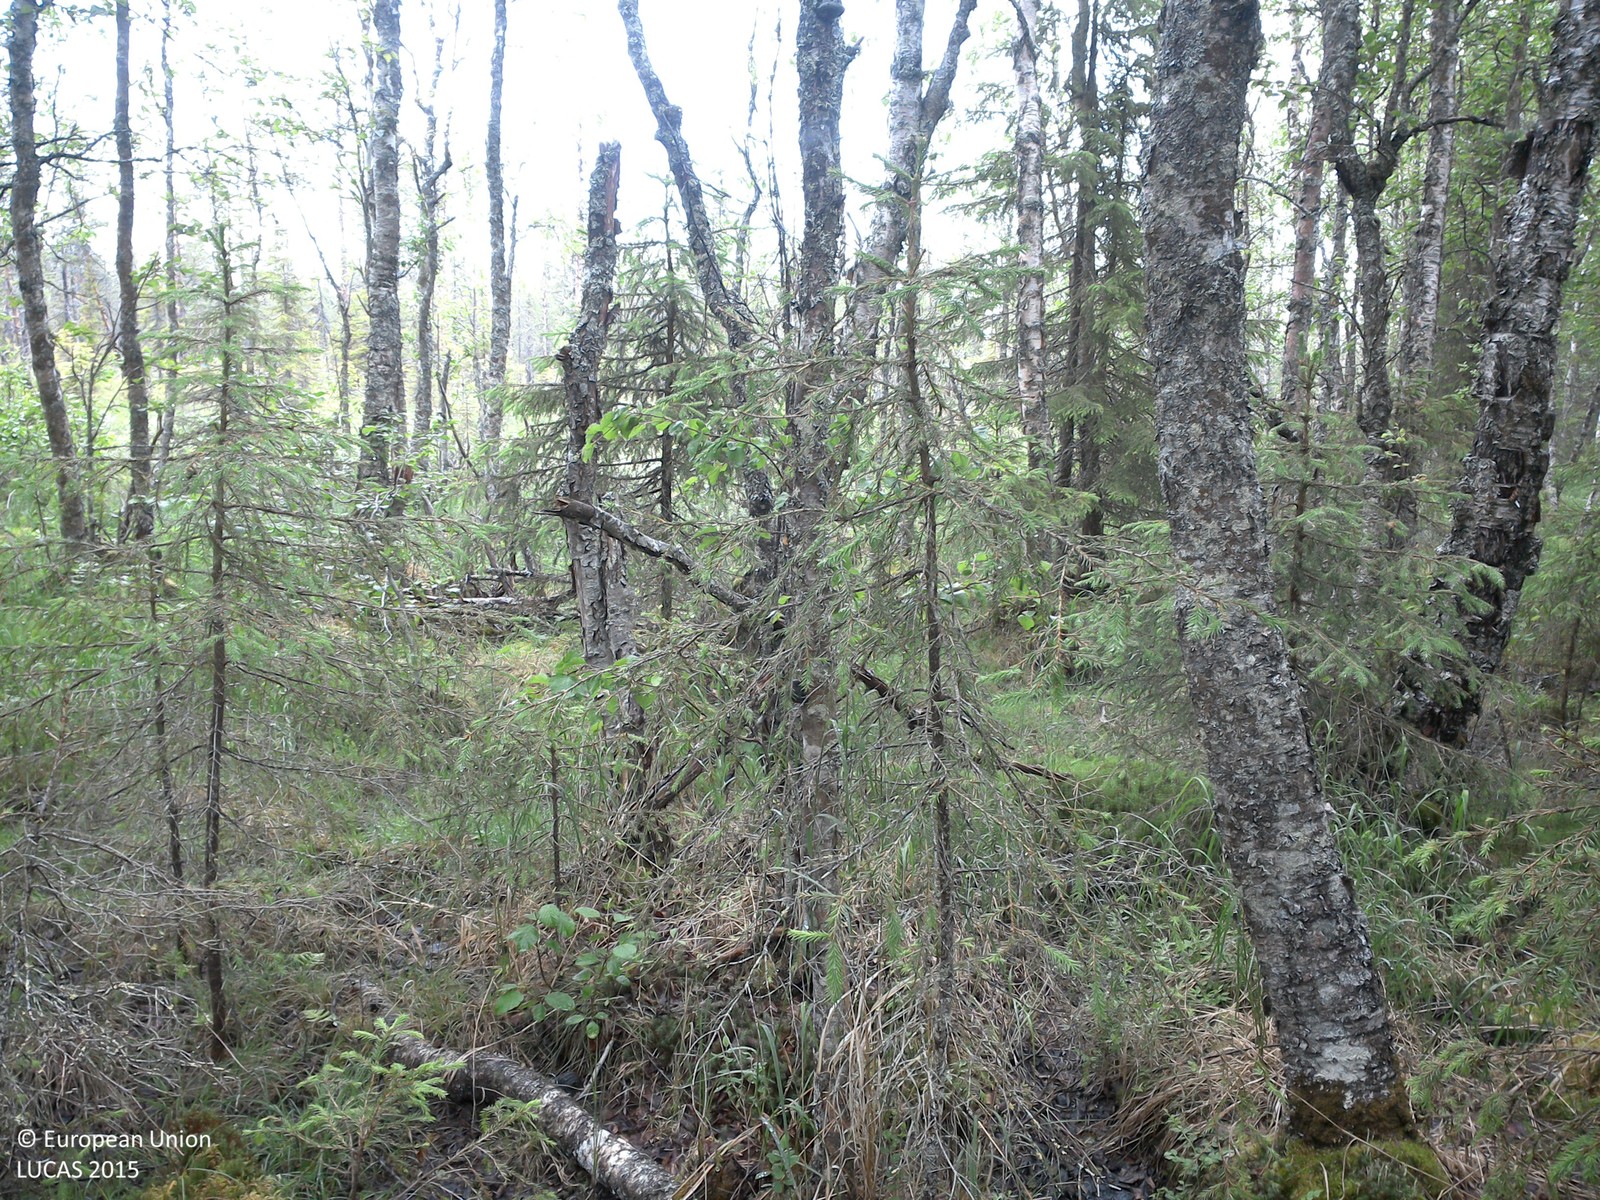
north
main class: Woodland
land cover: Other mixed woodland
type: boreal forest
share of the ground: 25 - 50 %
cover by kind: lichens and mosses 35 %, broadleaved forest trees 30 %, herbaceous plants 25 %, coniferous forest trees 10 %
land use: Forestry
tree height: > 5 m
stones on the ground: < 10 %
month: July
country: SE
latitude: 67.0145
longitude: 23.5860
